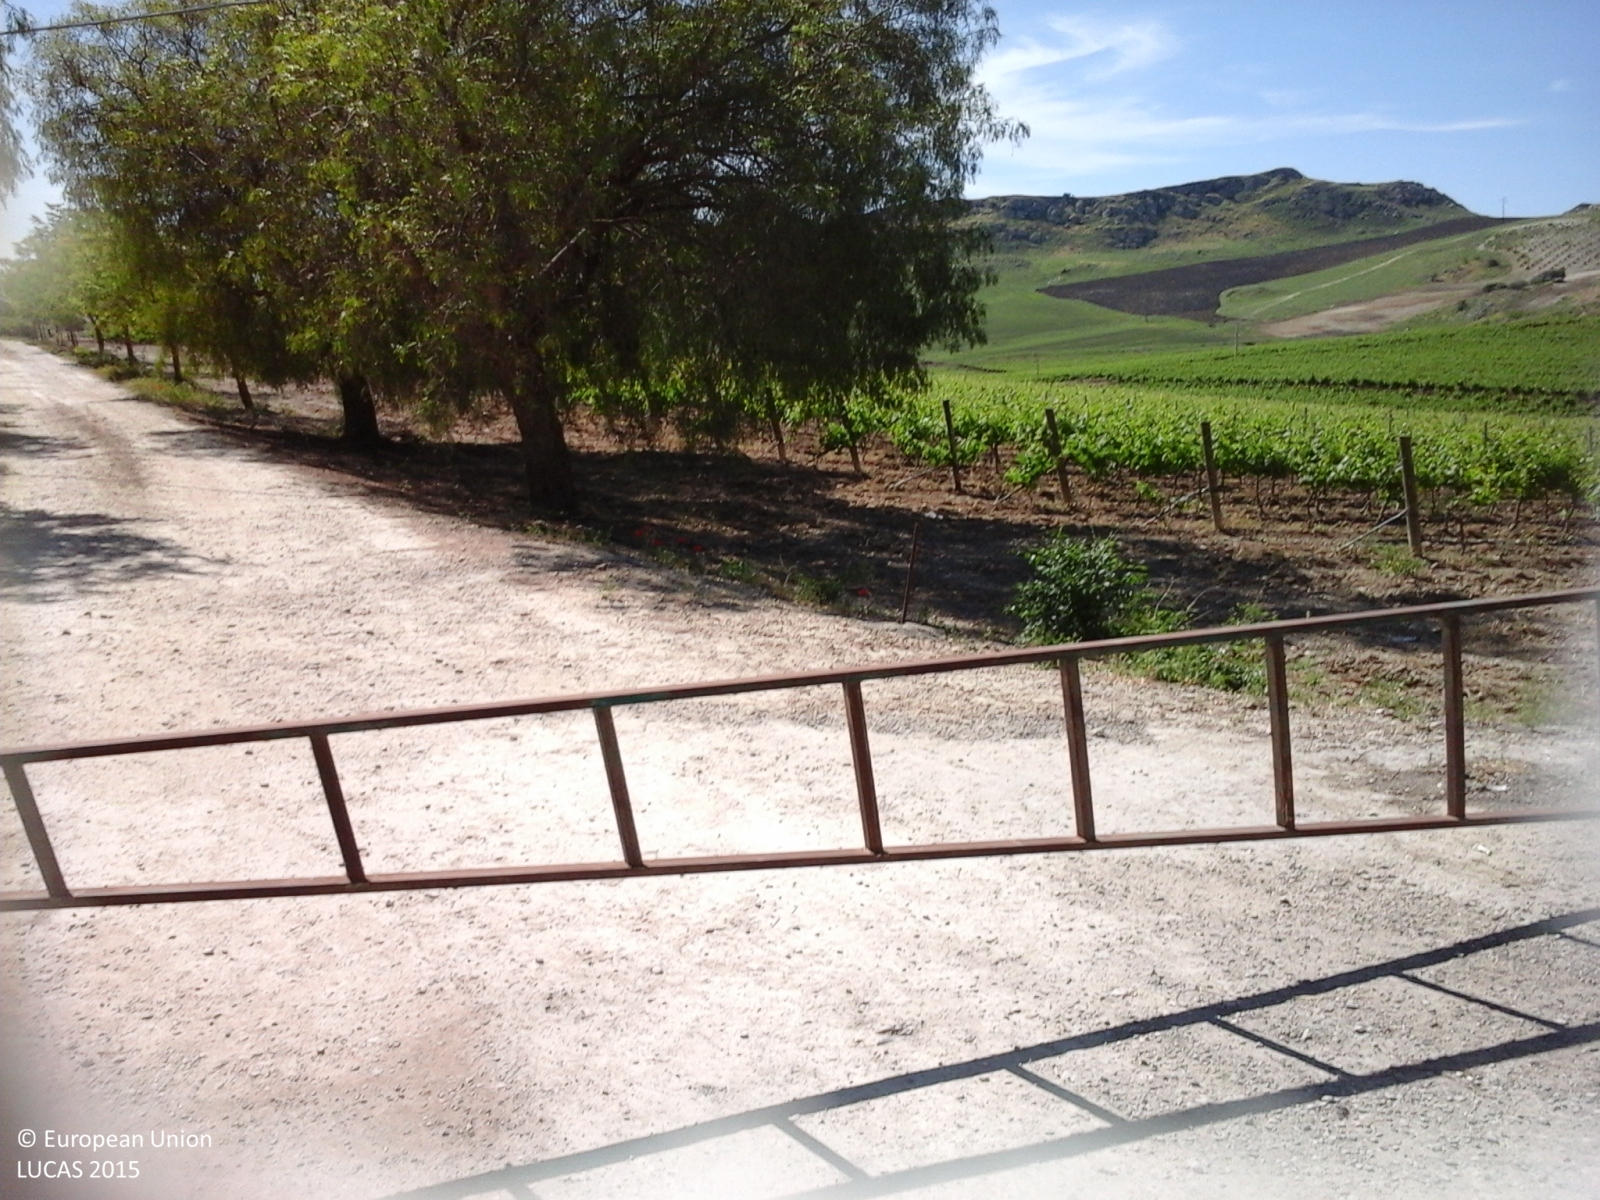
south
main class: Cropland
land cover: Vineyards
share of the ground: > 75 %
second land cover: Other bare soil
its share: > 75 %
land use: Agriculture (excluding fallow land and kitchen gardens)
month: May
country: IT
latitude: 37.4279
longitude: 13.9816
